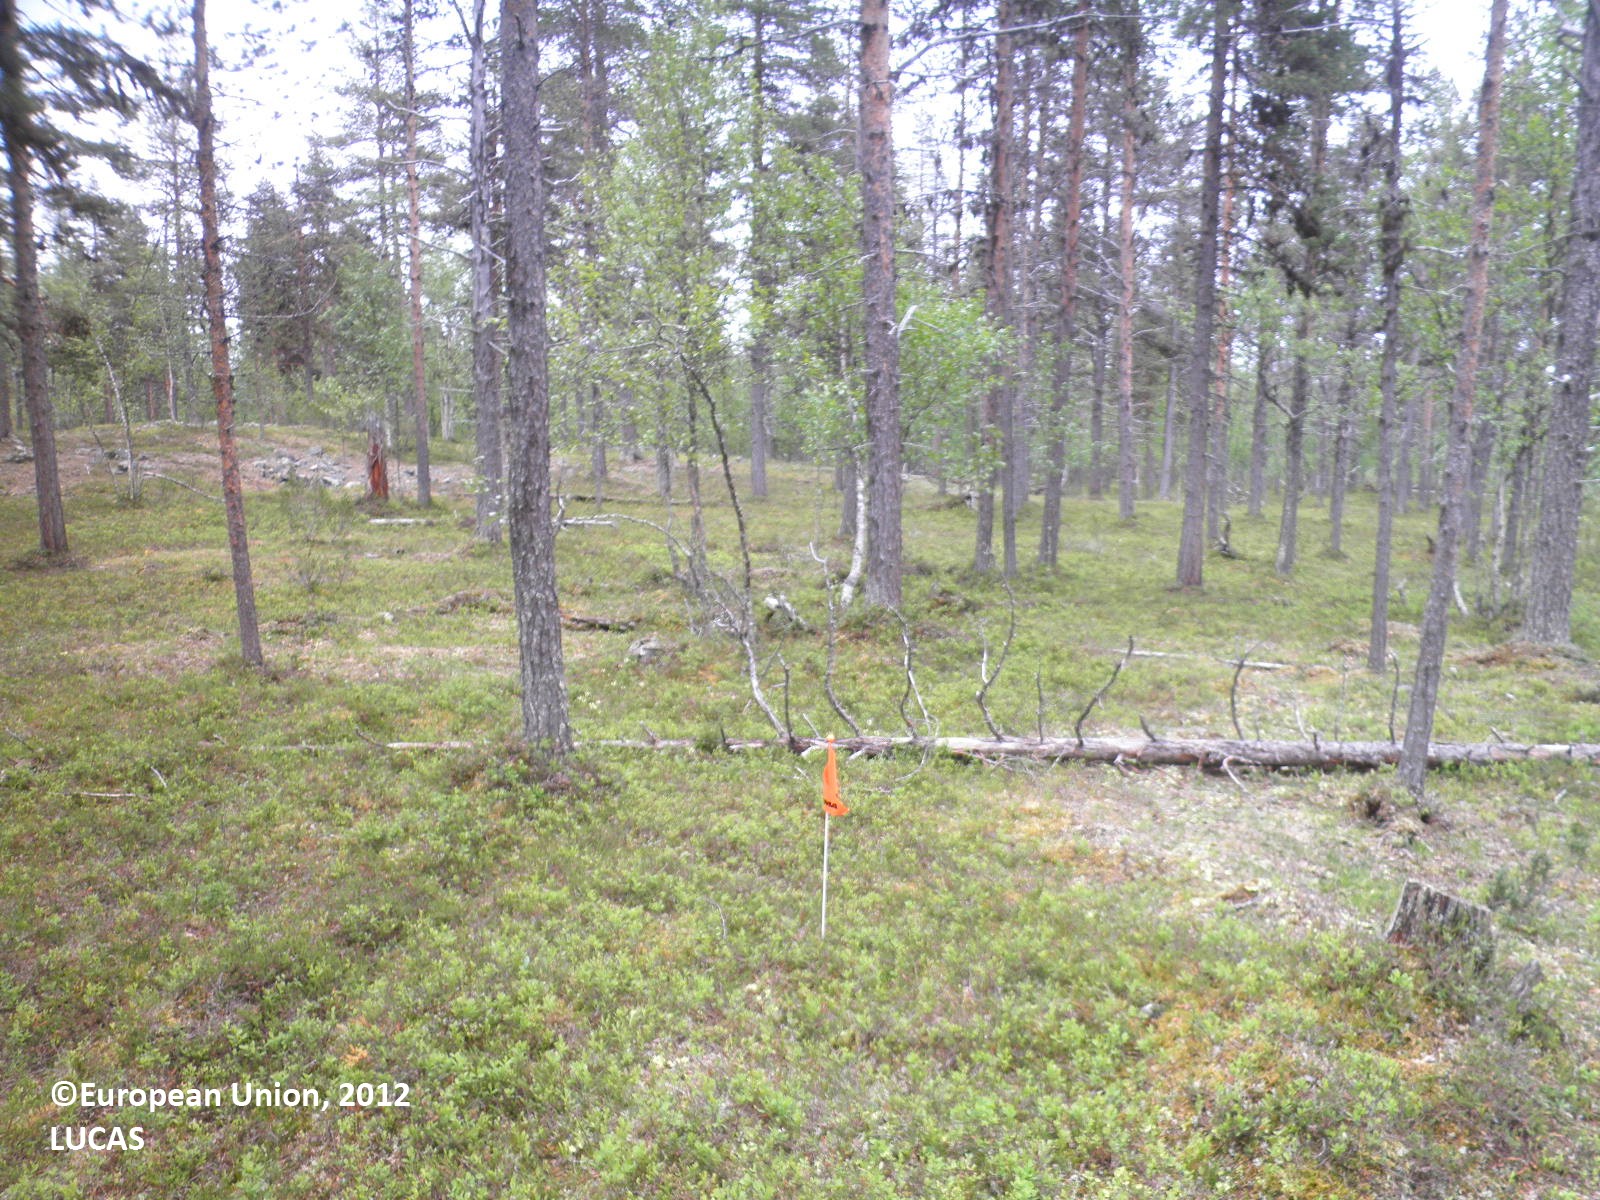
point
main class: Woodland
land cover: Pine dominated coniferous woodland
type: boreal forest
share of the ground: 25 - 50 %
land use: Forestry
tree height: > 5 m
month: July
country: FI
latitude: 68.4322
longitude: 25.9115
